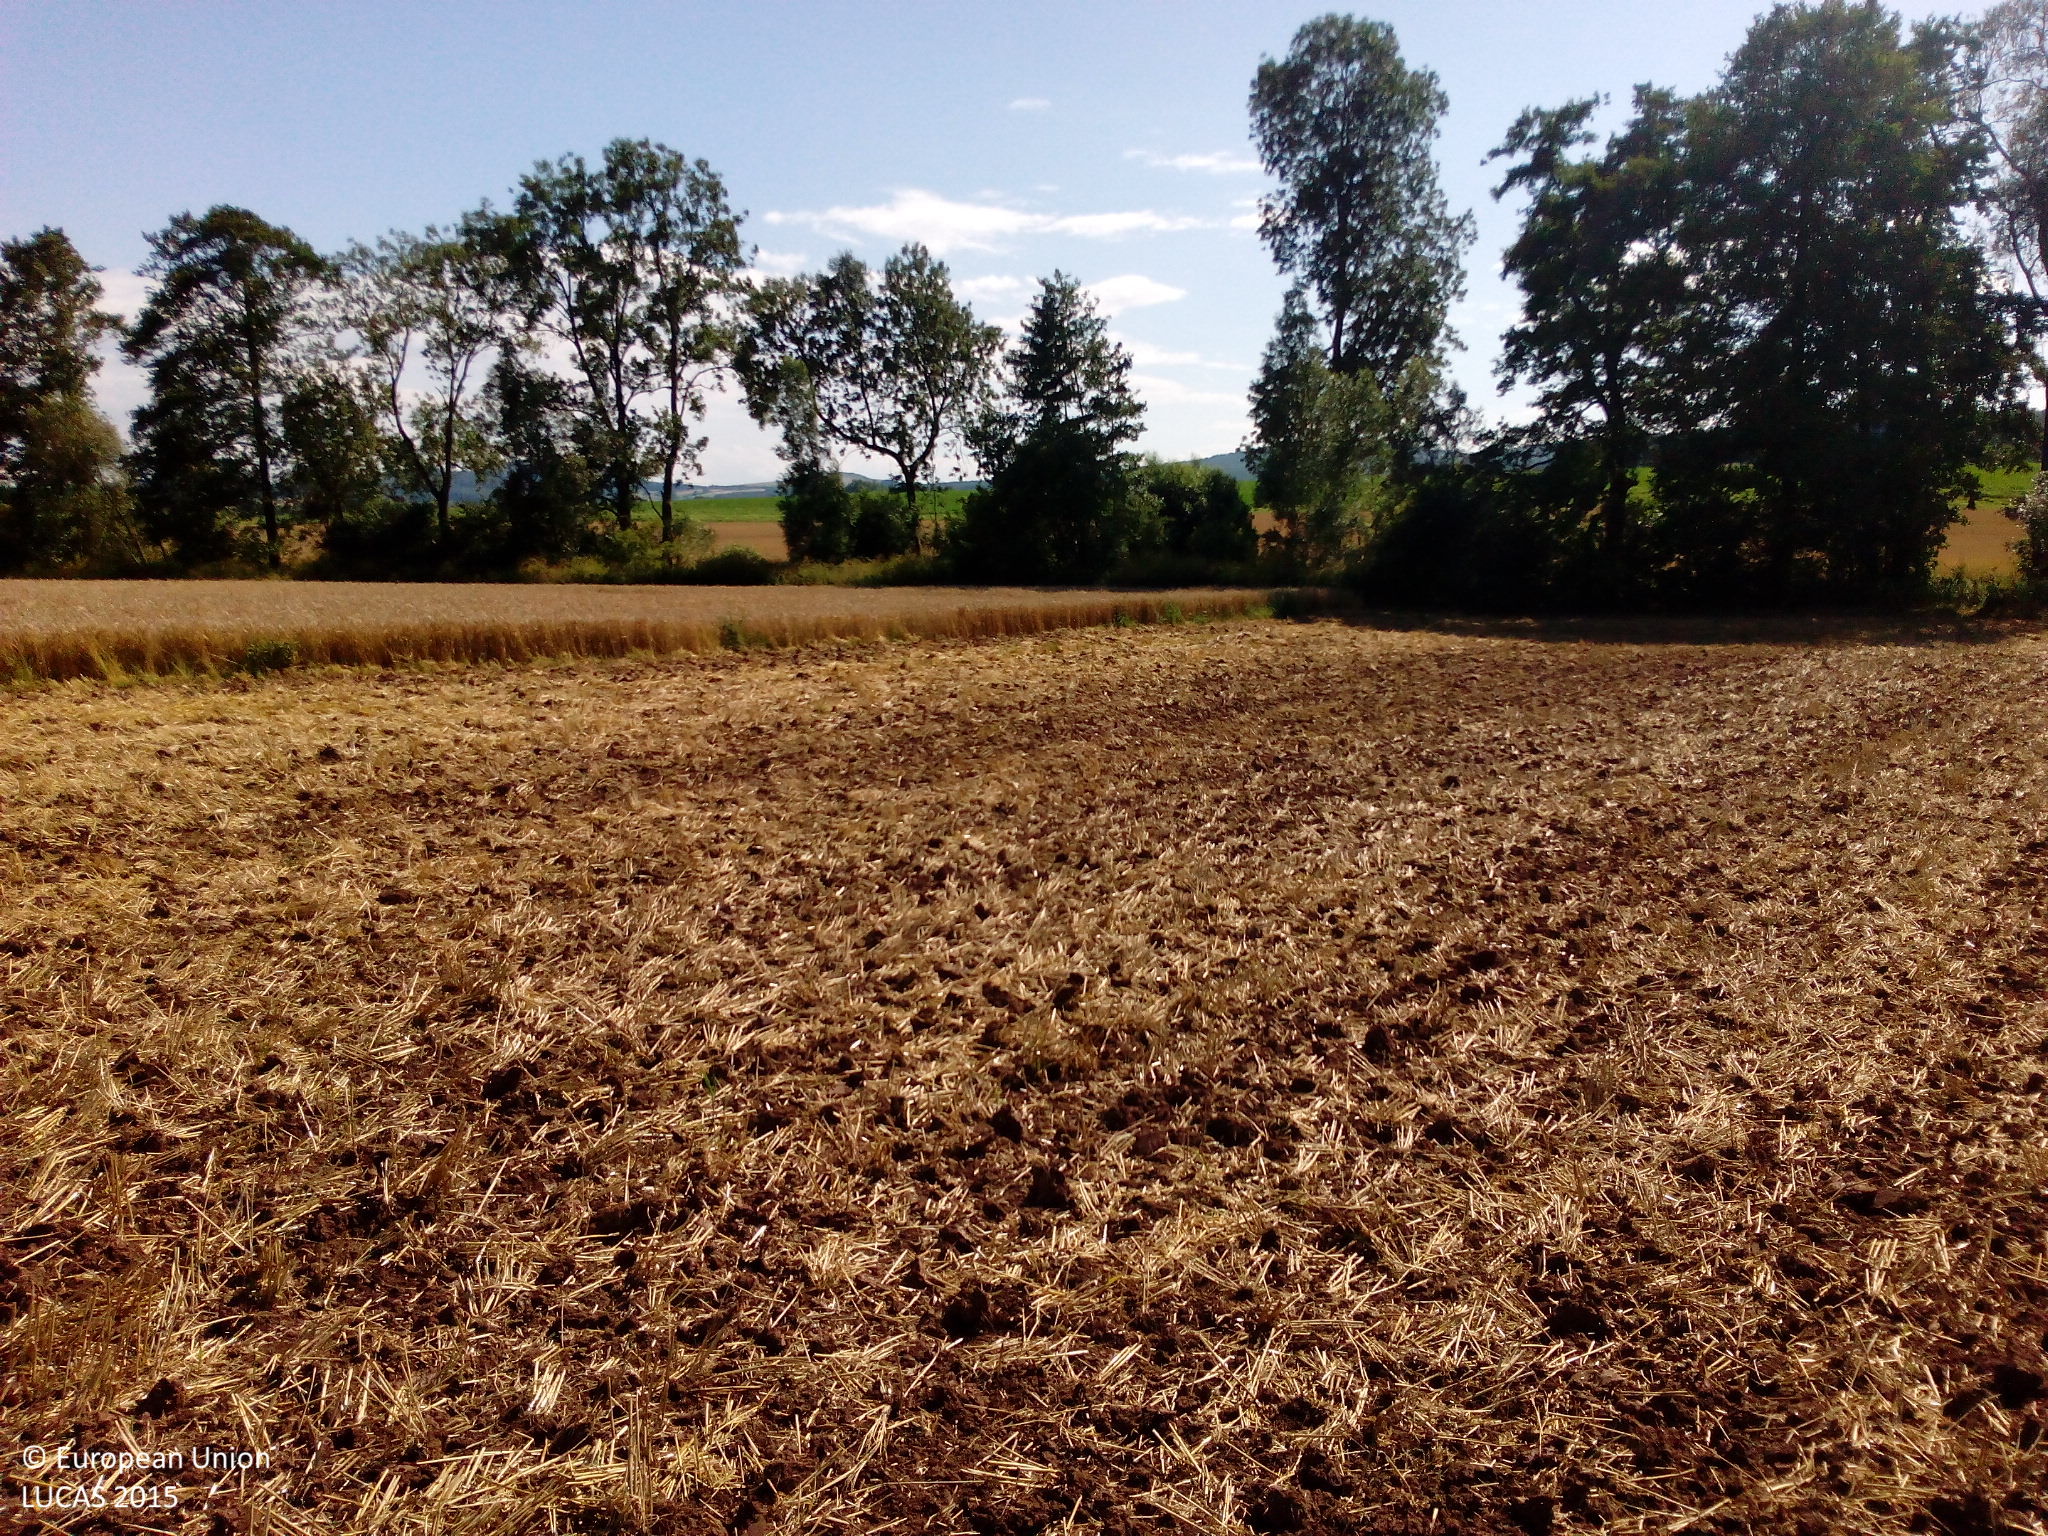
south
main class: Cropland
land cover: Barley
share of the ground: < 10 %
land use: Agriculture (excluding fallow land and kitchen gardens)
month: July
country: DE
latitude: 51.4230
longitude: 9.3530
